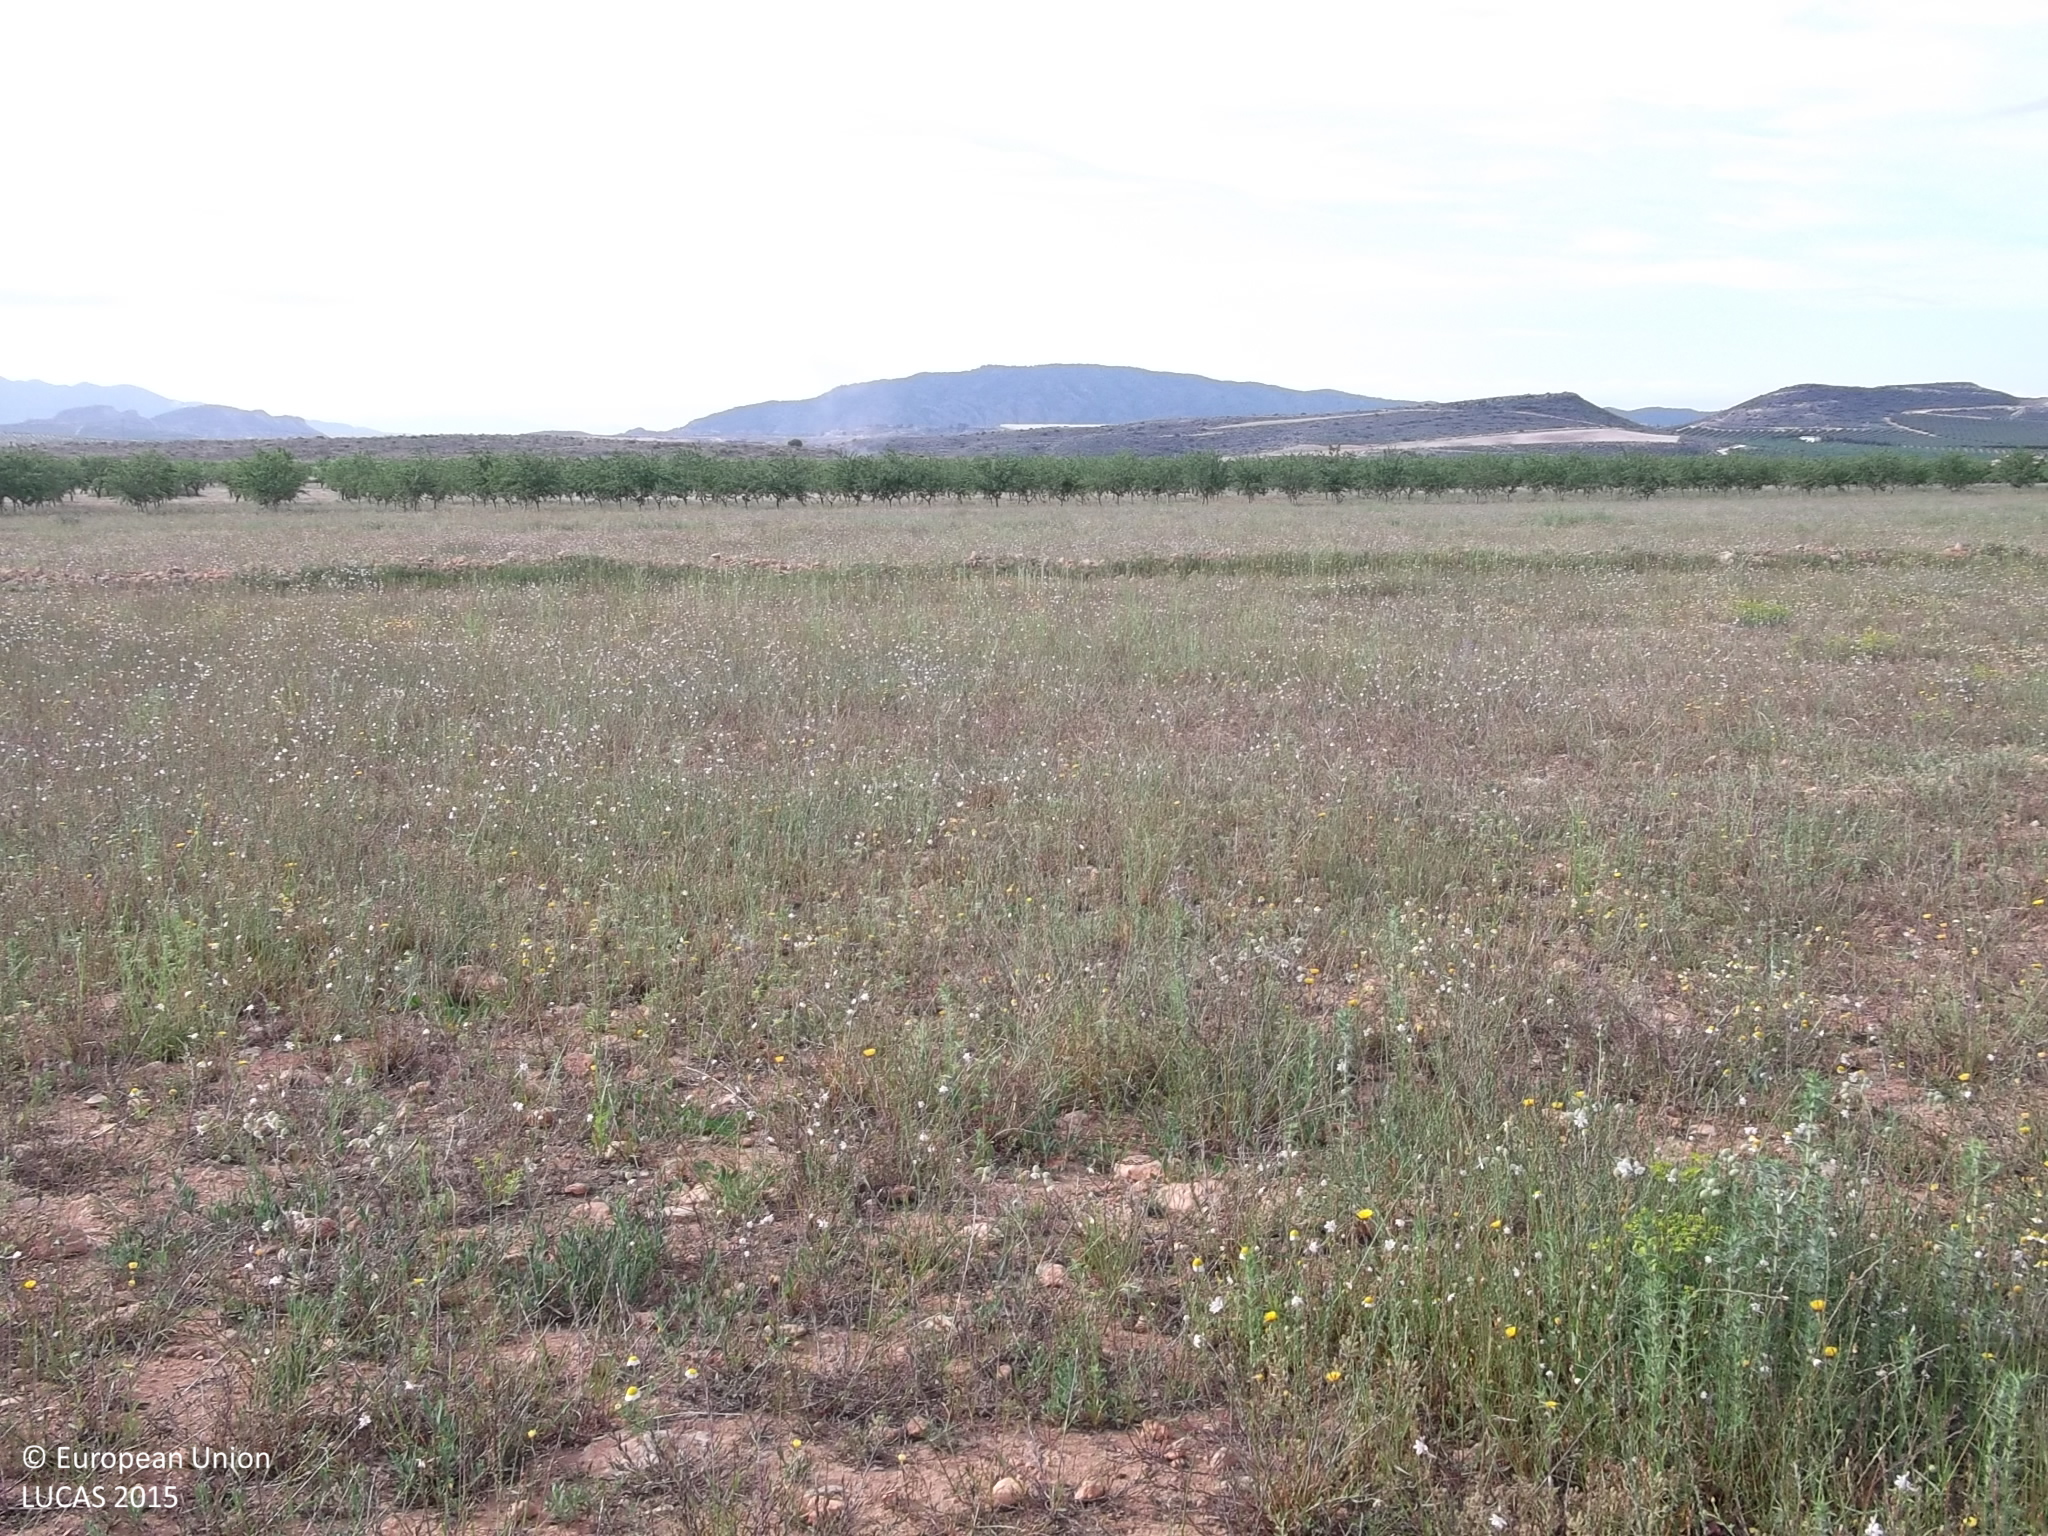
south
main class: Grassland
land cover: Spontaneously vegetated surfaces
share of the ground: 50 - 75 %
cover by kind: herbaceous plants 75 %, unconsolidated bare surface 25 %
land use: Fallow land
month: April
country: ES
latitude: 37.9534
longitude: -1.4225
